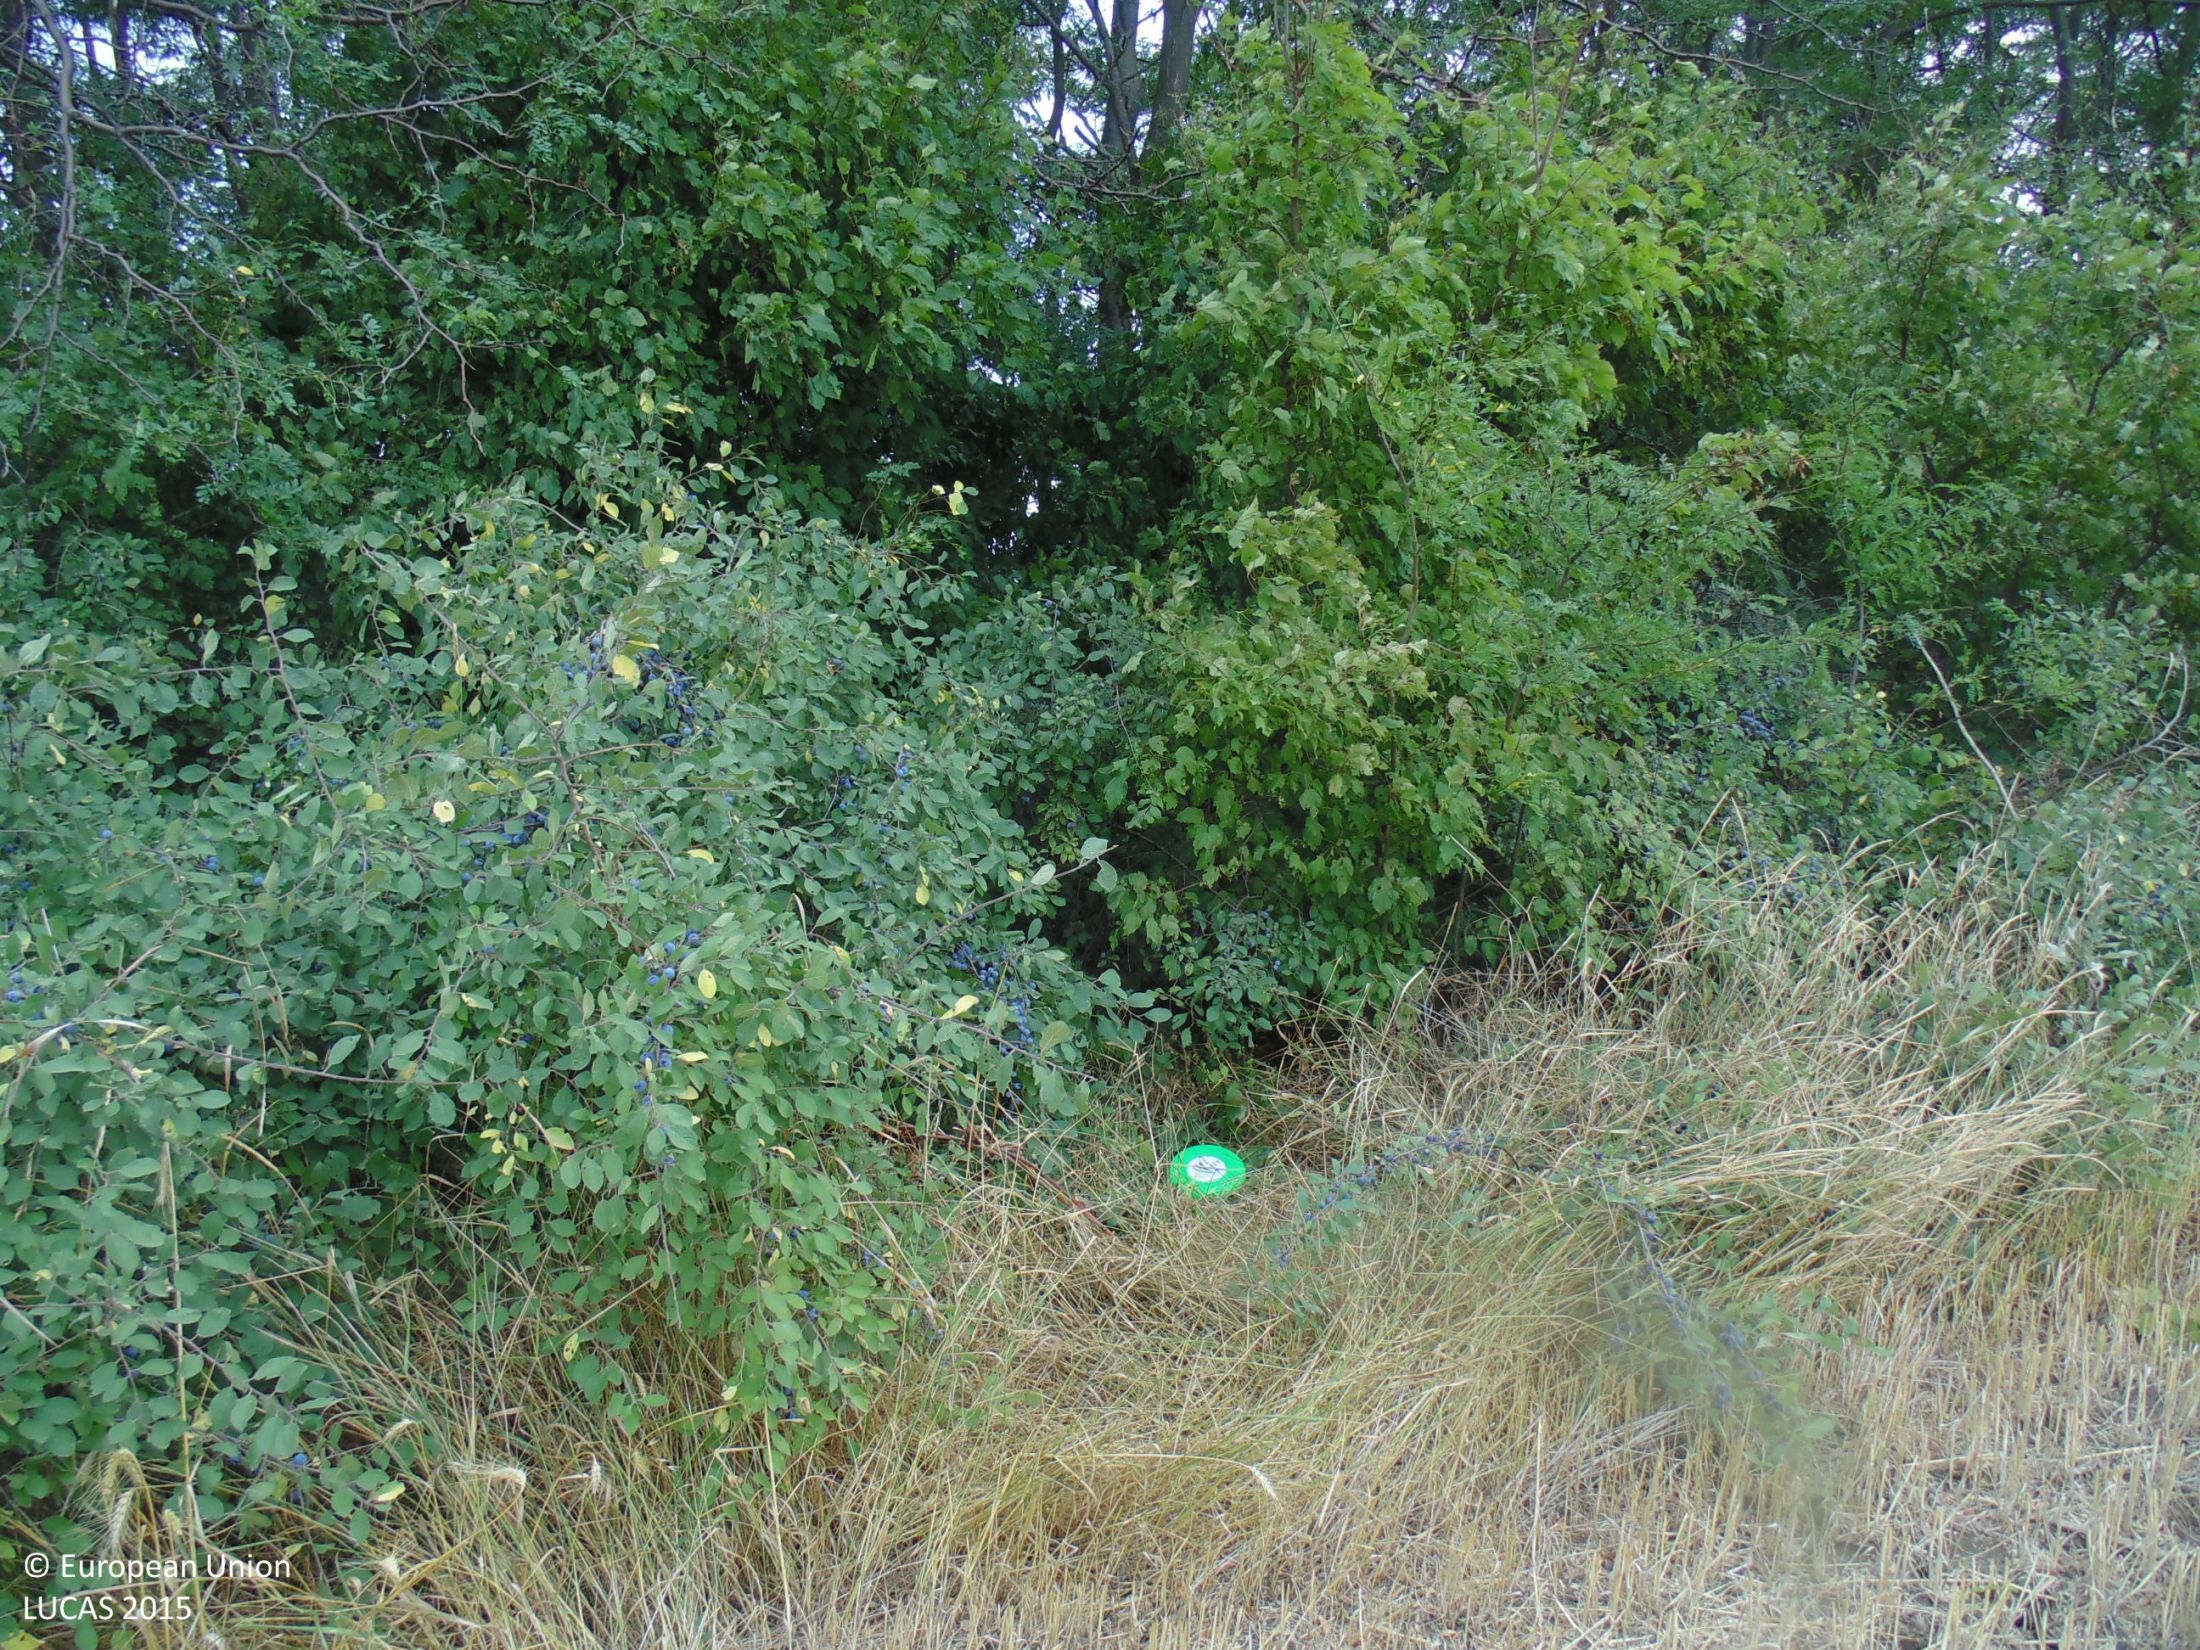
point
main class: Woodland
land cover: Broadleaved woodland
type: mesophytic deciduous forest
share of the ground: > 75 %
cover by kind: broadleaved forest trees 90 %, shrubs 10 %
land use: Forestry
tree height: > 5 m
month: August
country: BG
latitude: 43.5784
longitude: 28.4765
